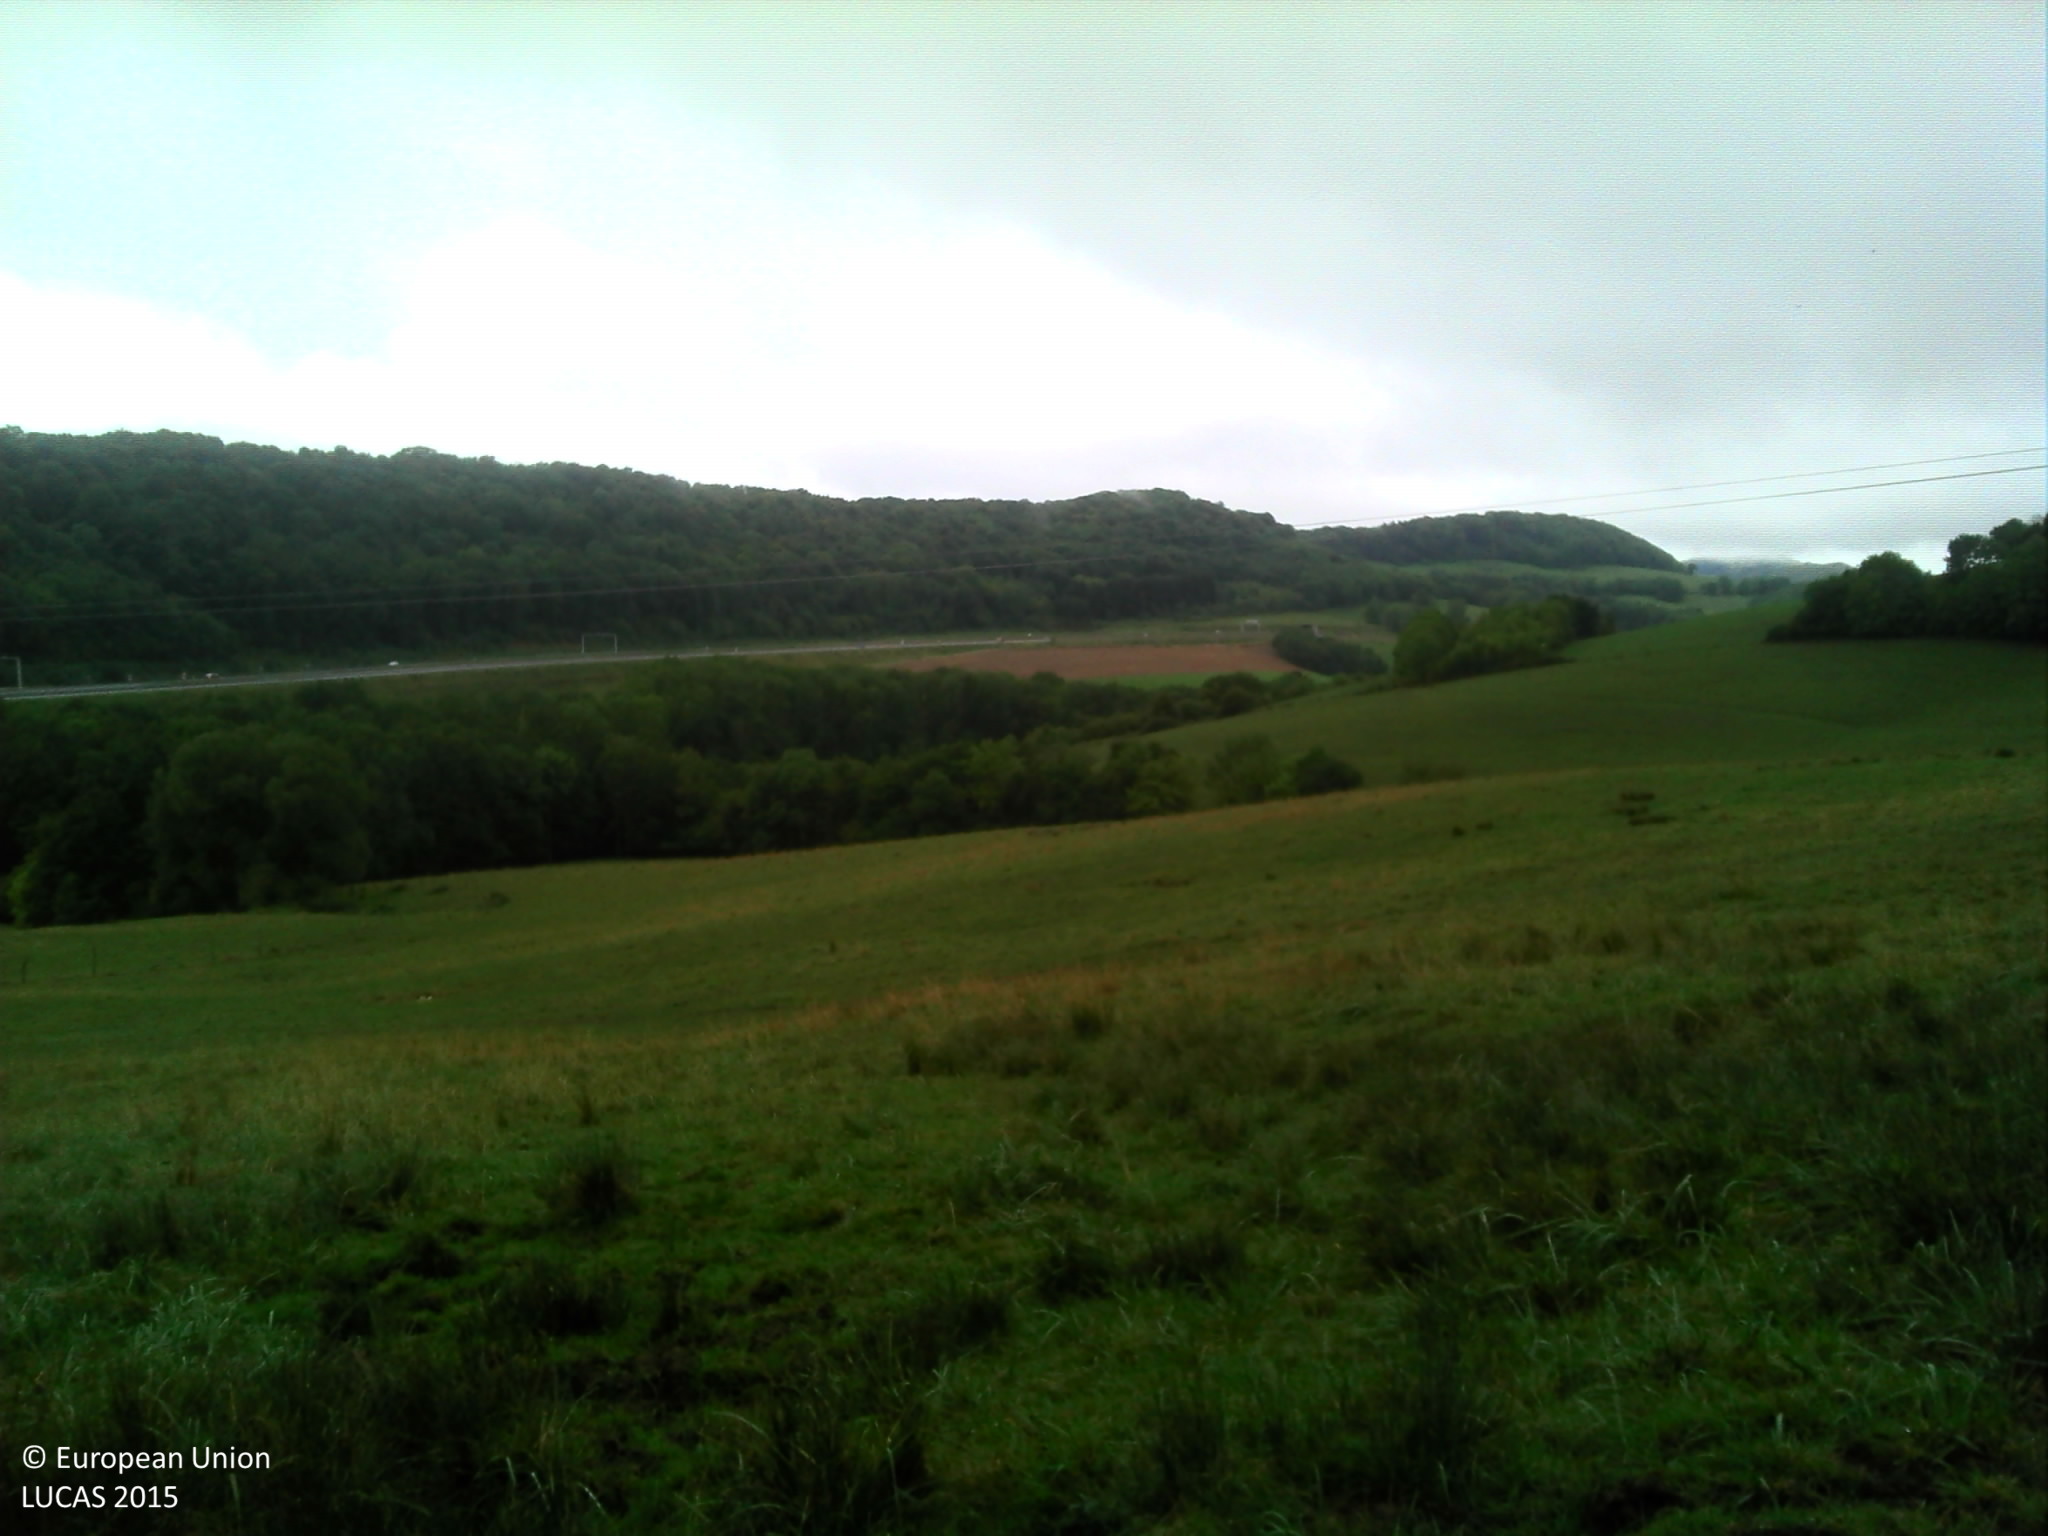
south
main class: Woodland
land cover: Broadleaved woodland
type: mesophytic deciduous forest
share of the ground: > 75 %
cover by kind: broadleaved forest trees 70 %, shrubs 20 %, herbaceous plants 10 %
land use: Semi-natural and natural areas not in use
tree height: > 5 m
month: September
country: FR
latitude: 47.2159
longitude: 6.0537
